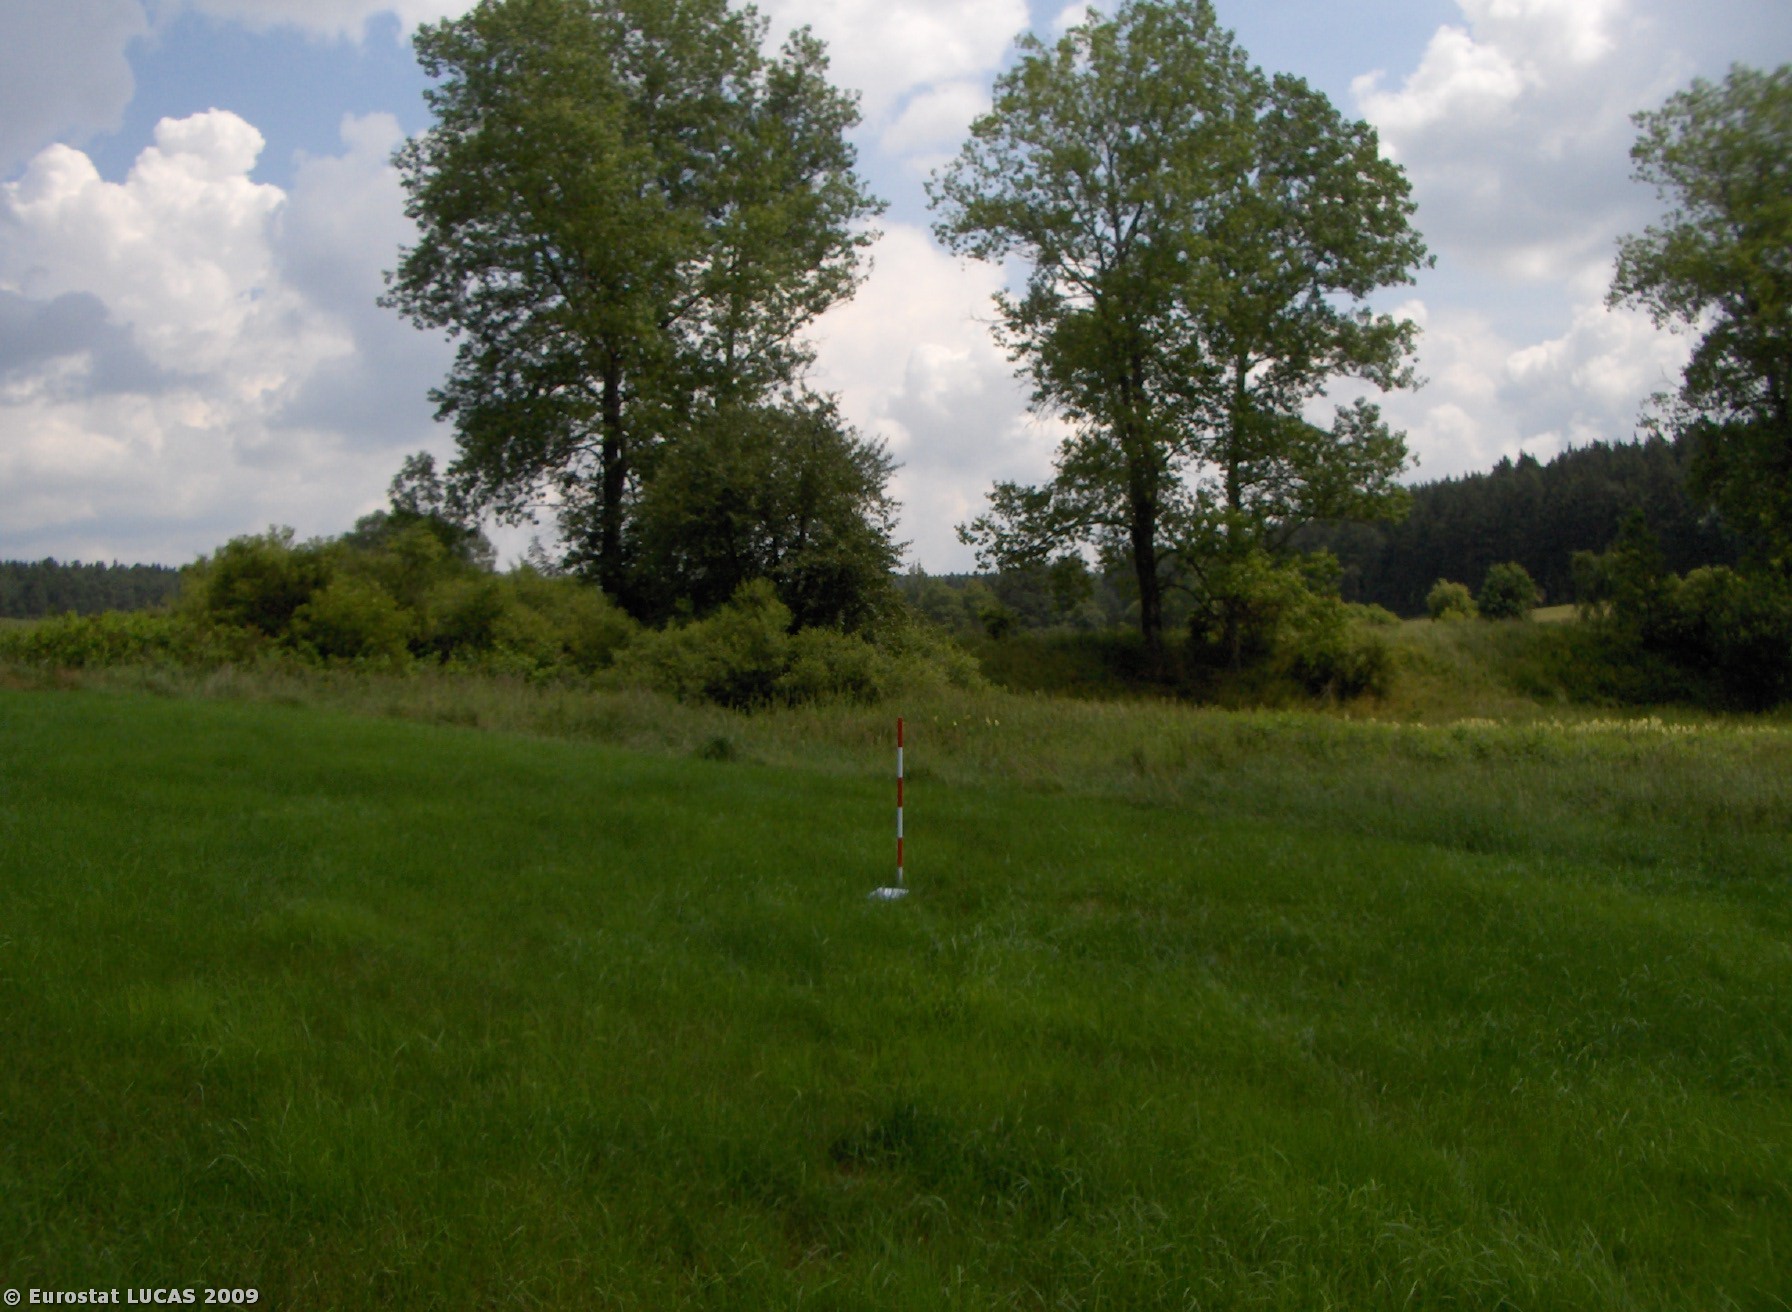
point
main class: Grassland
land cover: Grassland without tree/shrub cover
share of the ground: > 75 %
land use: Agriculture (excluding fallow land and kitchen gardens)
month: July
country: CZ
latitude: 49.5816
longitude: 13.1949
